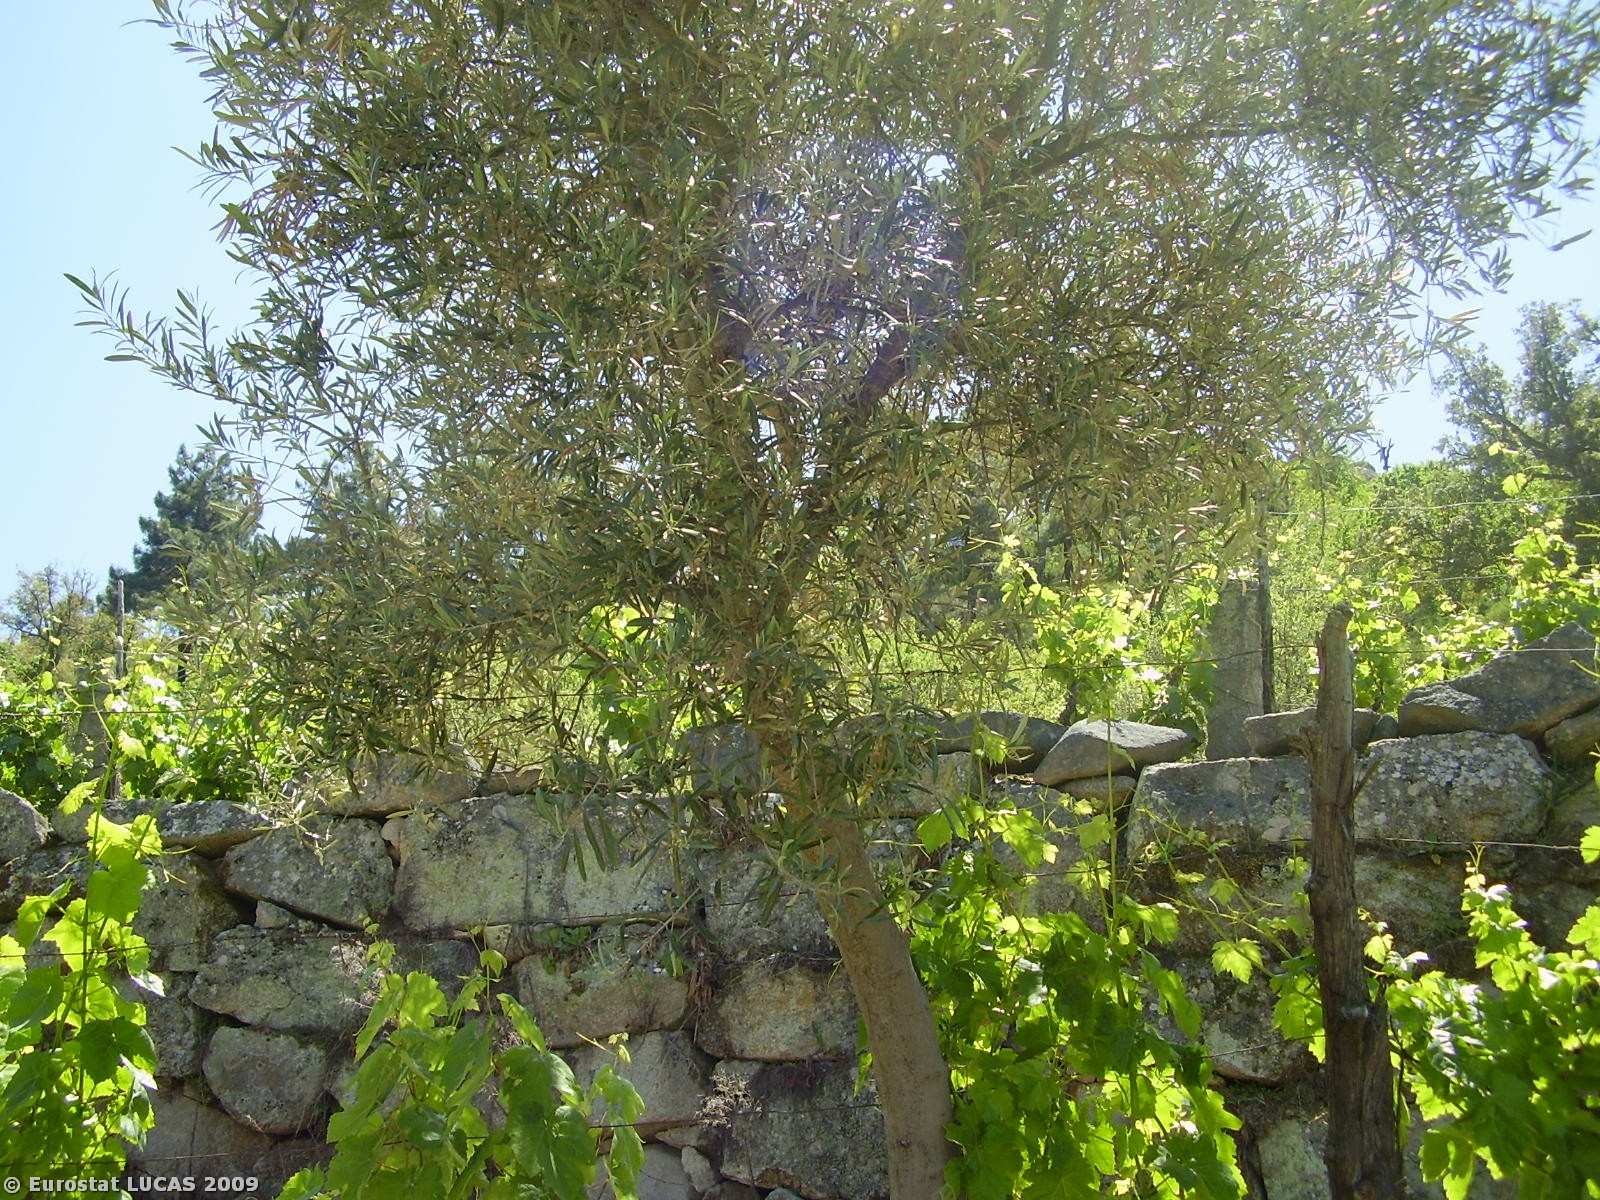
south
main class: Cropland
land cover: Vineyards
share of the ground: 10 - 25 %
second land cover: Bare land
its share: > 75 %
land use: Agriculture (excluding fallow land and kitchen gardens)
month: May
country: PT
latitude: 41.3203
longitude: -7.2861
